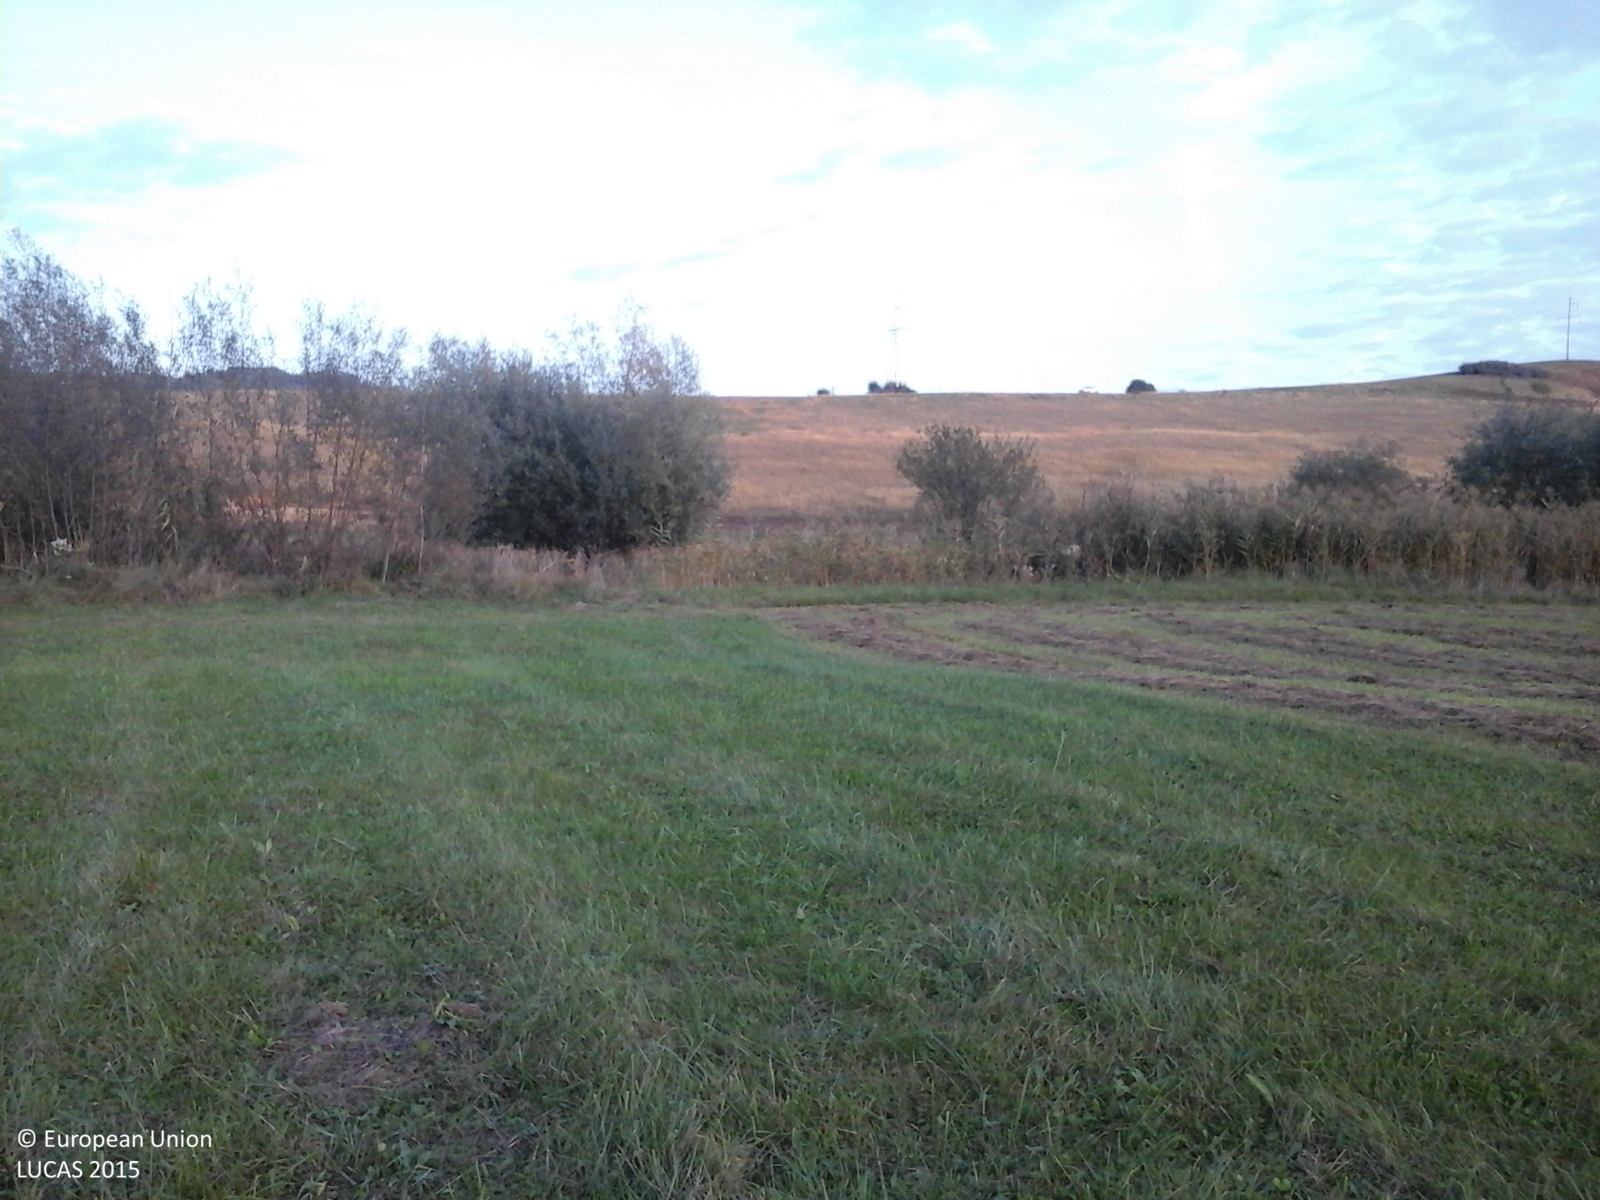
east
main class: Grassland
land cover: Grassland without tree/shrub cover
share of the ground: > 75 %
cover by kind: herbaceous plants 100 %
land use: Agriculture (excluding fallow land and kitchen gardens)
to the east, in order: Grassland without tree/shrub cover; Grass margins; Lines of trees; Ditches and canals; Grassland with sparse tree/shrub cover; Inland marshes; Tracks; Grass margins; Tracks; Other bare soil; Grassland without tree/shrub cover; Tracks; Grassland without tree/shrub cover; Rape and turnip rape
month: October
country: RO
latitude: 46.2845
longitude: 24.2667
